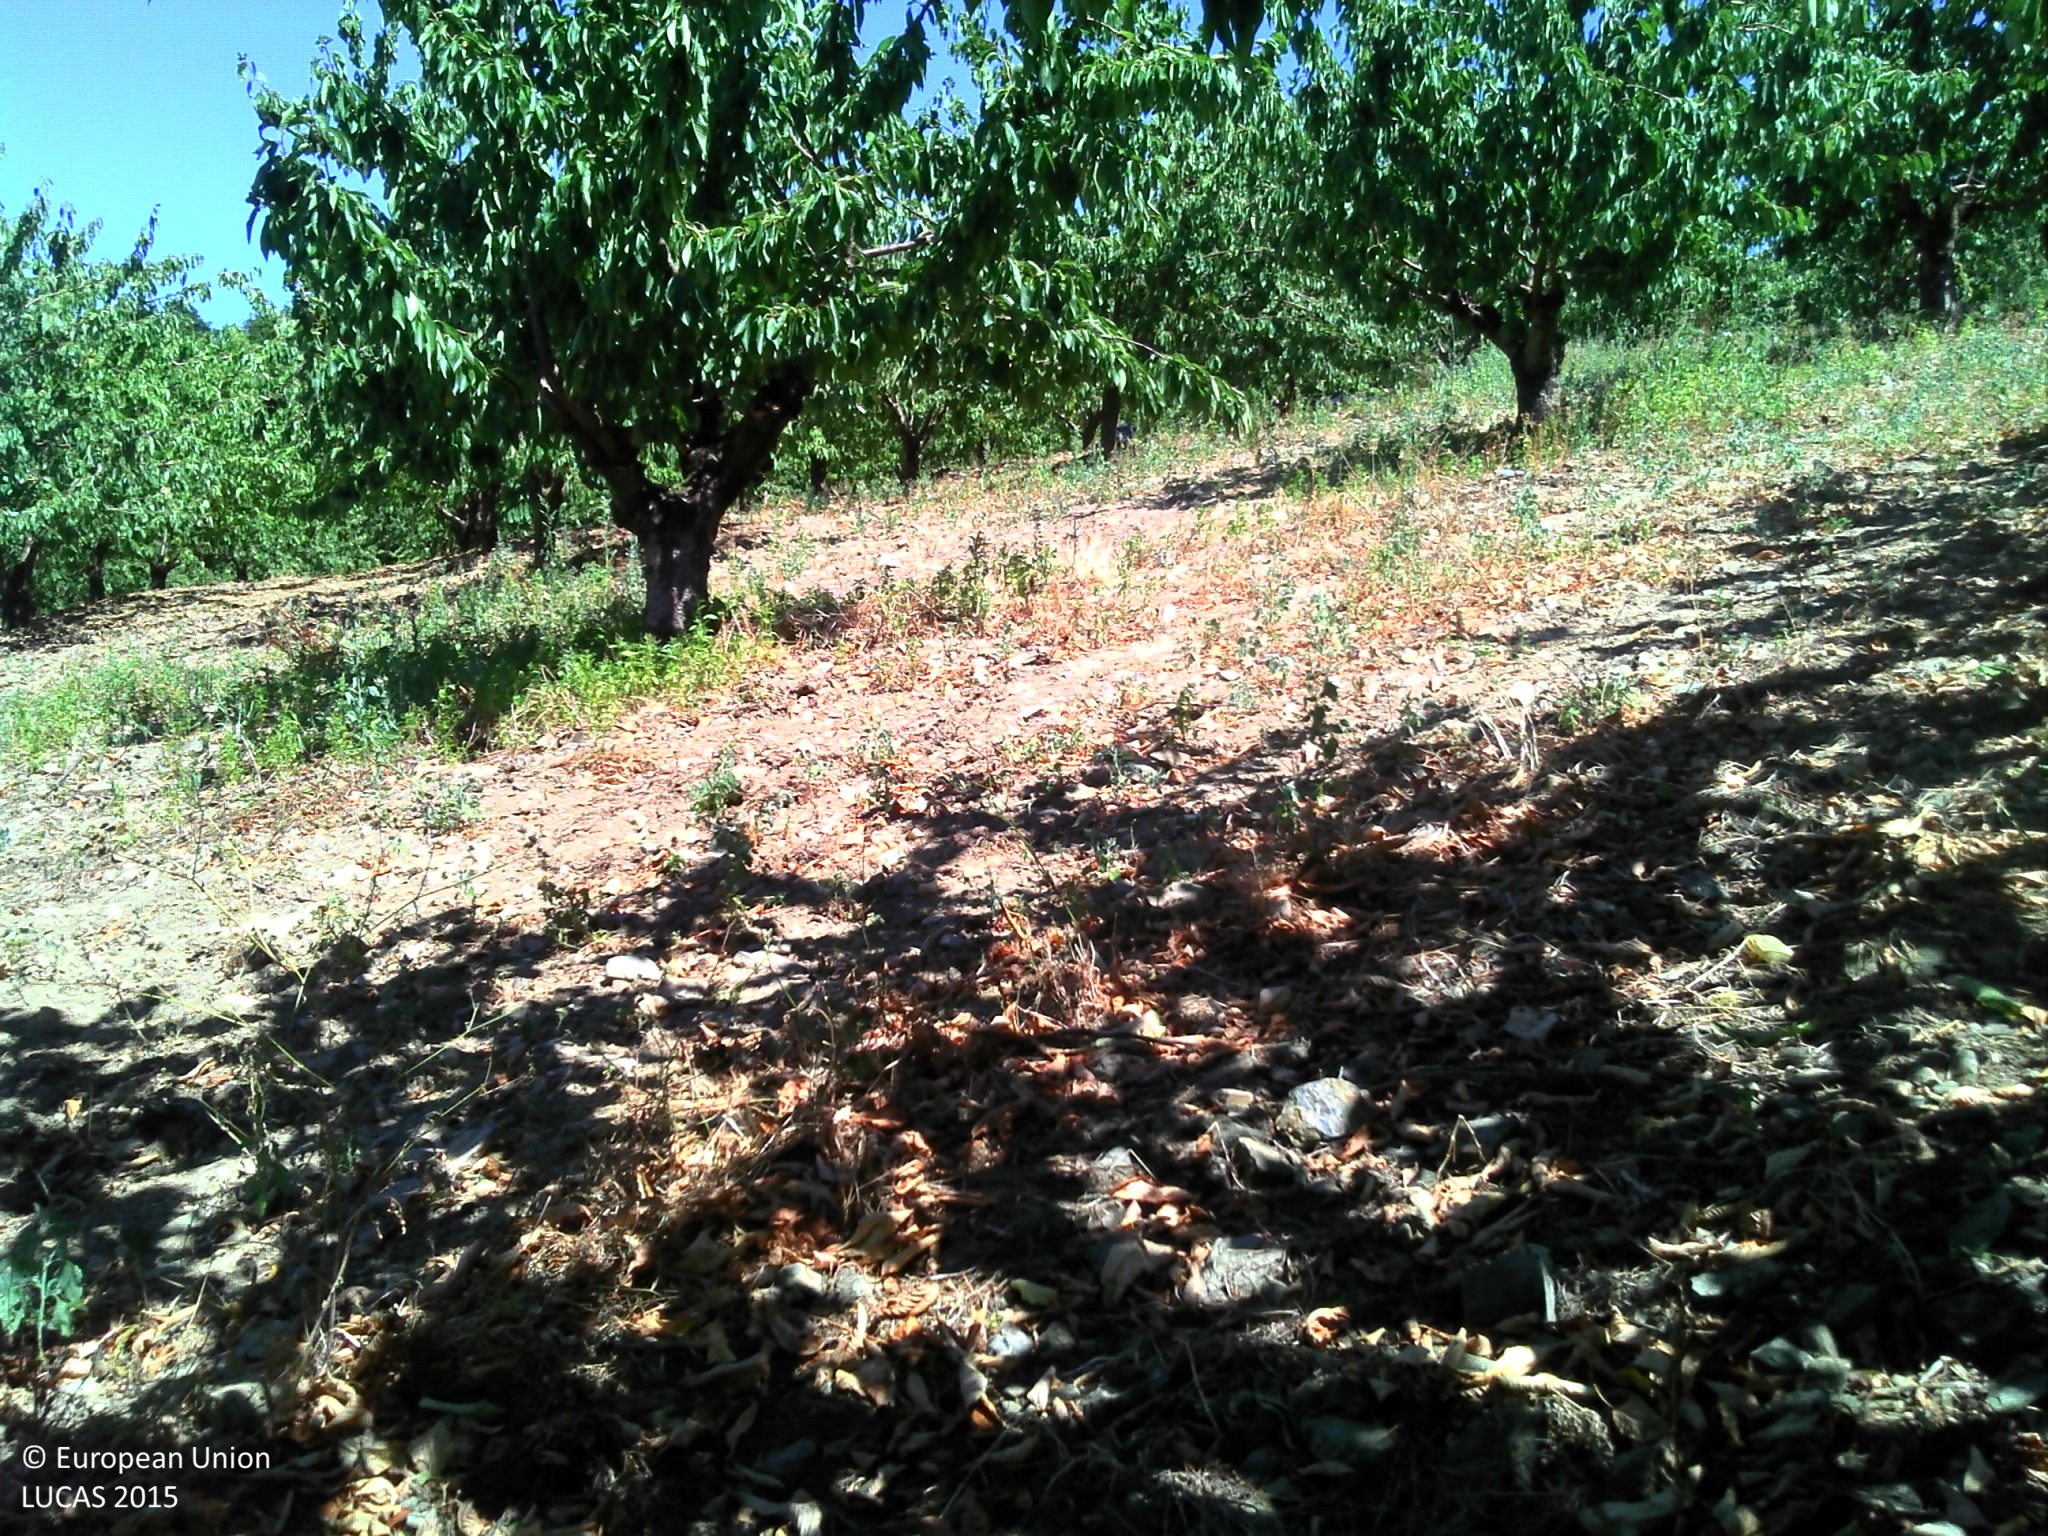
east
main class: Cropland
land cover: Cherry fruit
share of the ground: > 75 %
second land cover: Other fruit trees and berries
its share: < 10 %
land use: Agriculture (excluding fallow land and kitchen gardens)
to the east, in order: Cherry fruit; Other fruit trees and berries; Tracks; Cherry fruit; Tracks; Abandoned hedges; Fences; Grassland without tree/shrub cover; Tracks; Broadleaved woodland
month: July
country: FR
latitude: 45.8335
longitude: 4.5574
